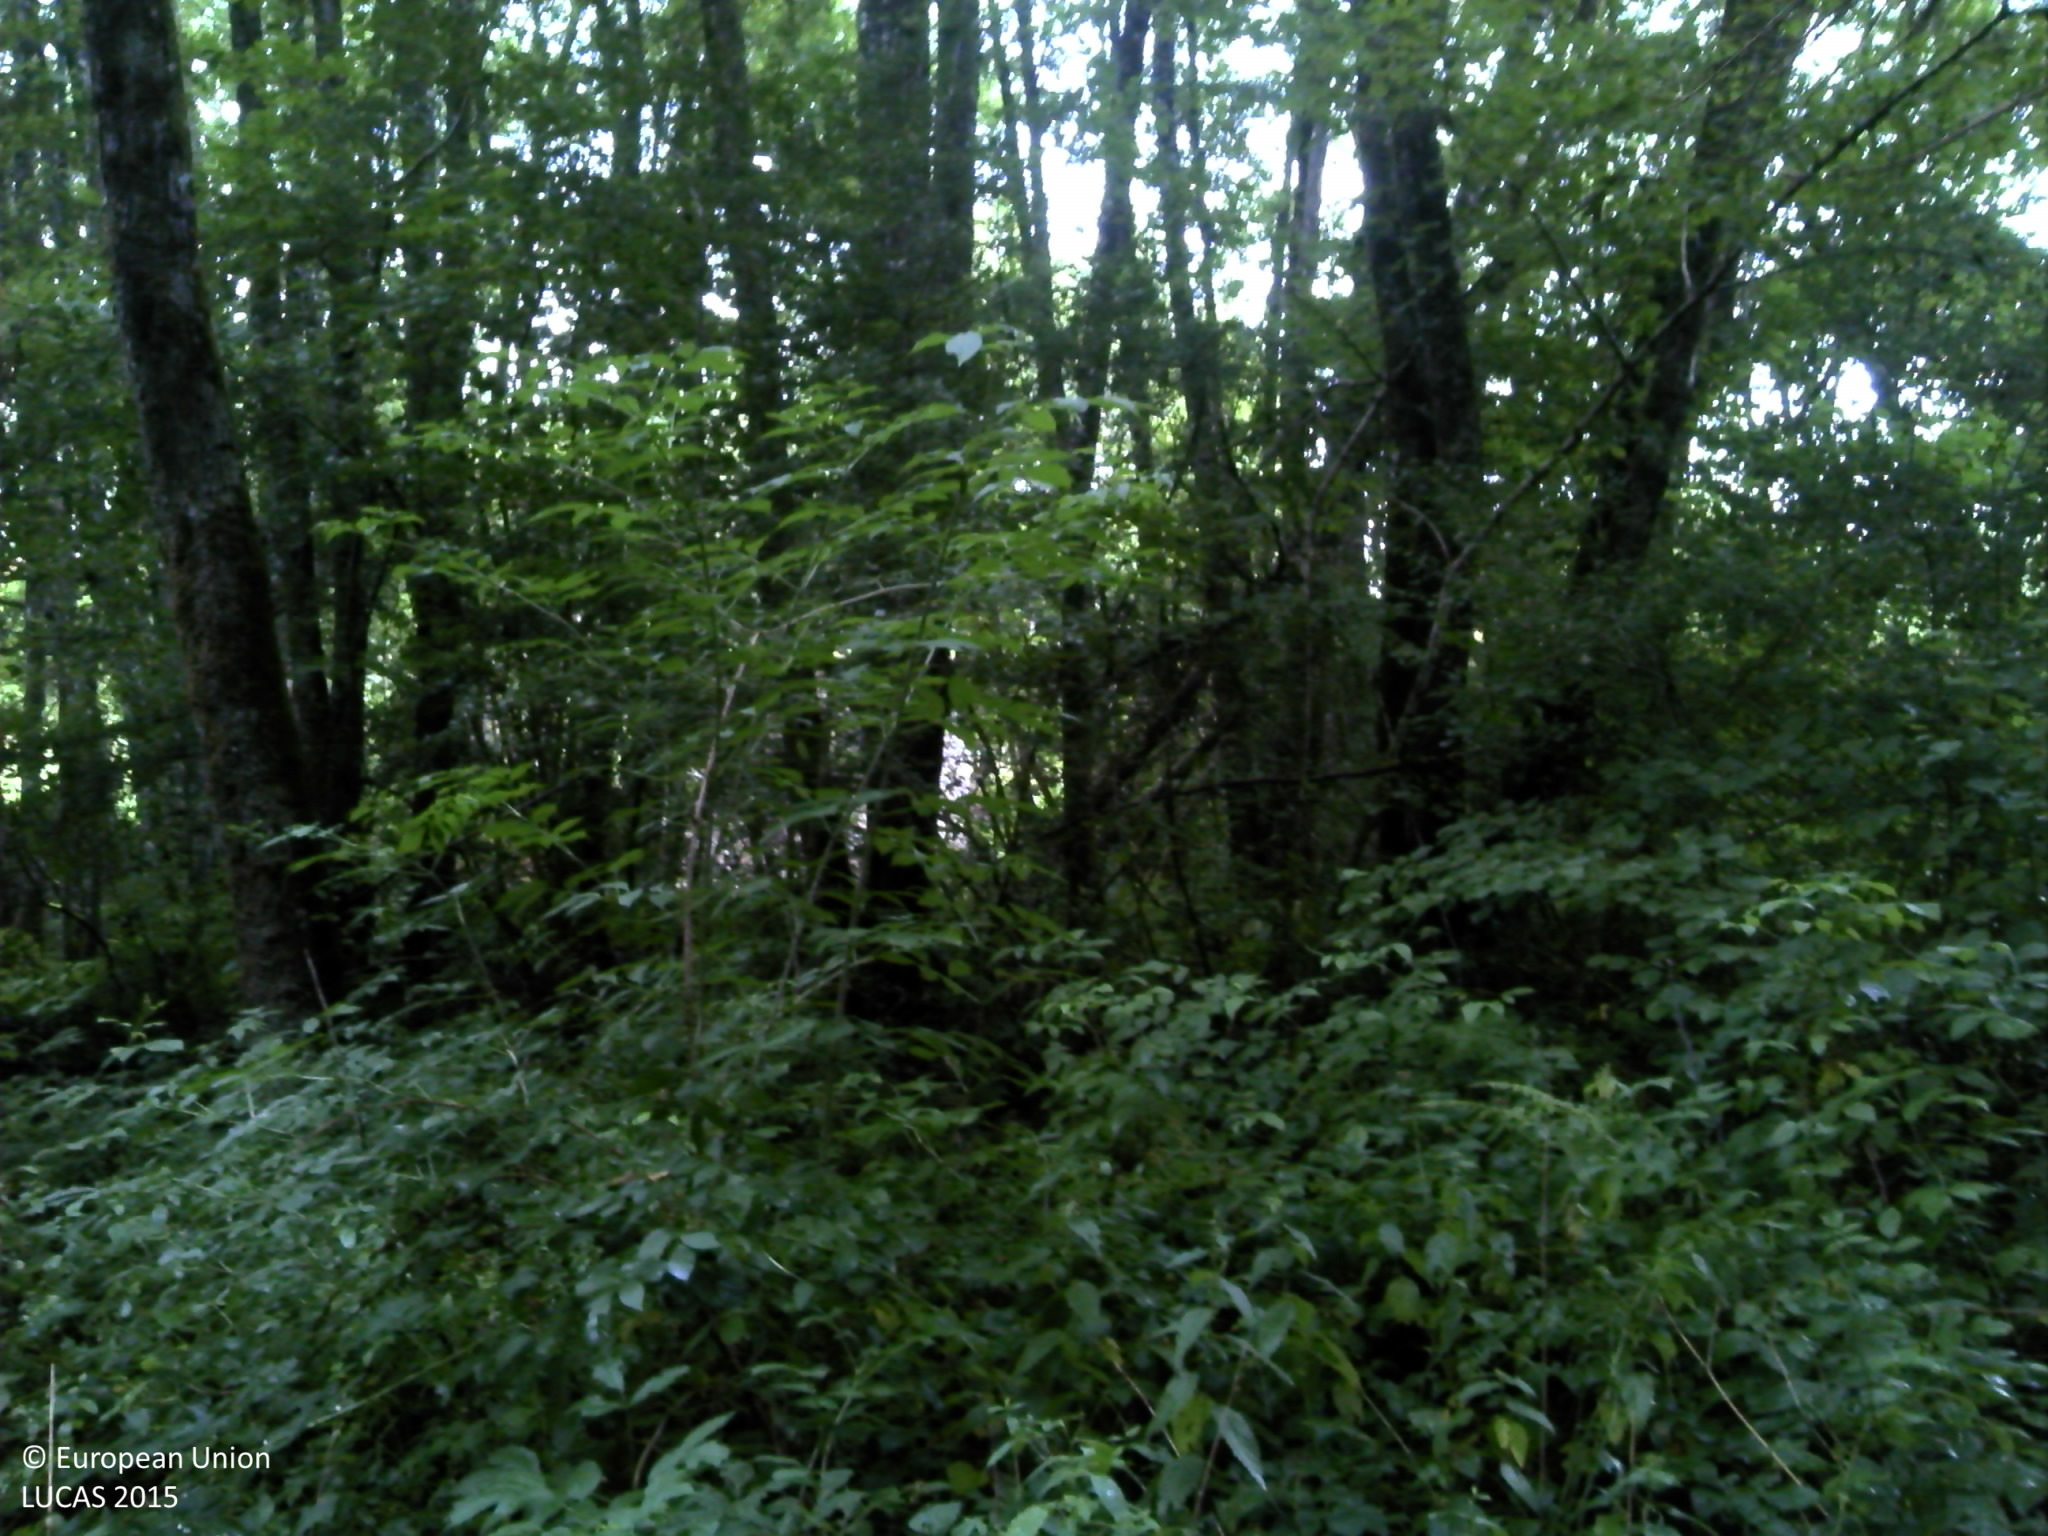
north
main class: Woodland
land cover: Spruce dominated coniferous woodland
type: exotic forest
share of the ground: > 75 %
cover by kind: coniferous forest trees 75 %, lichens and mosses 20 %, herbaceous plants 5 %
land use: Forestry
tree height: > 5 m
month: August
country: FR
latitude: 45.4628
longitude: 2.3629
